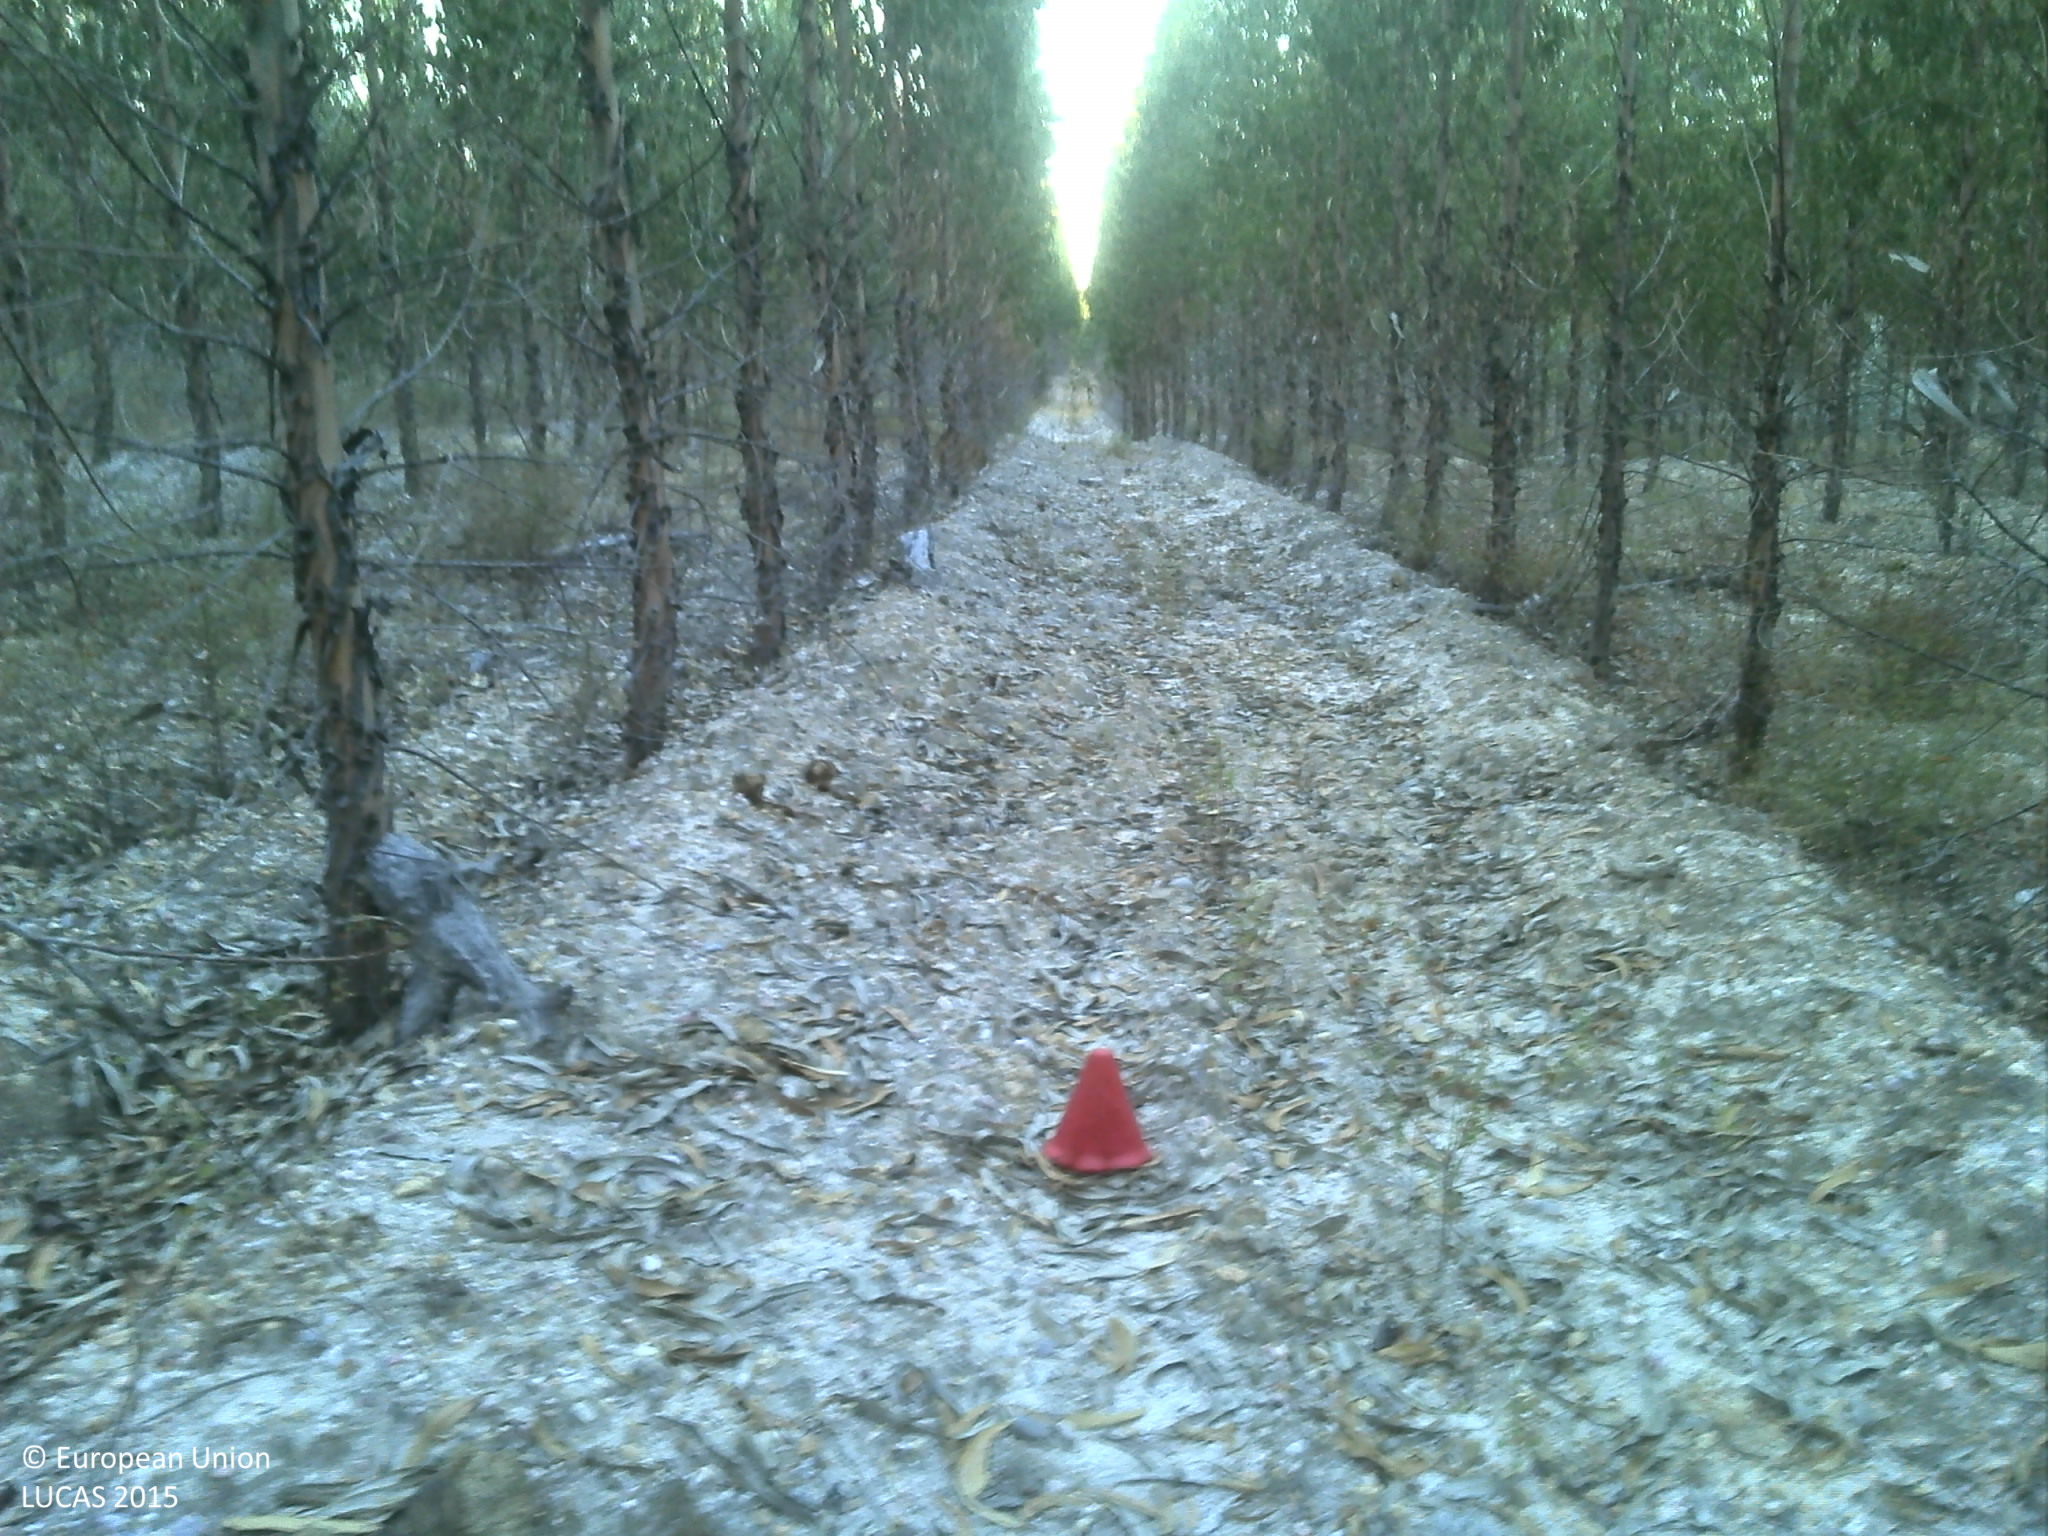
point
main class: Woodland
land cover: Broadleaved woodland
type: exotic forest
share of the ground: 50 - 75 %
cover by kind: broadleaved forest trees 60 %, unconsolidated bare surface 40 %
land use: Forestry
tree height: > 5 m
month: July
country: PT
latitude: 39.0076
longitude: -8.6002
